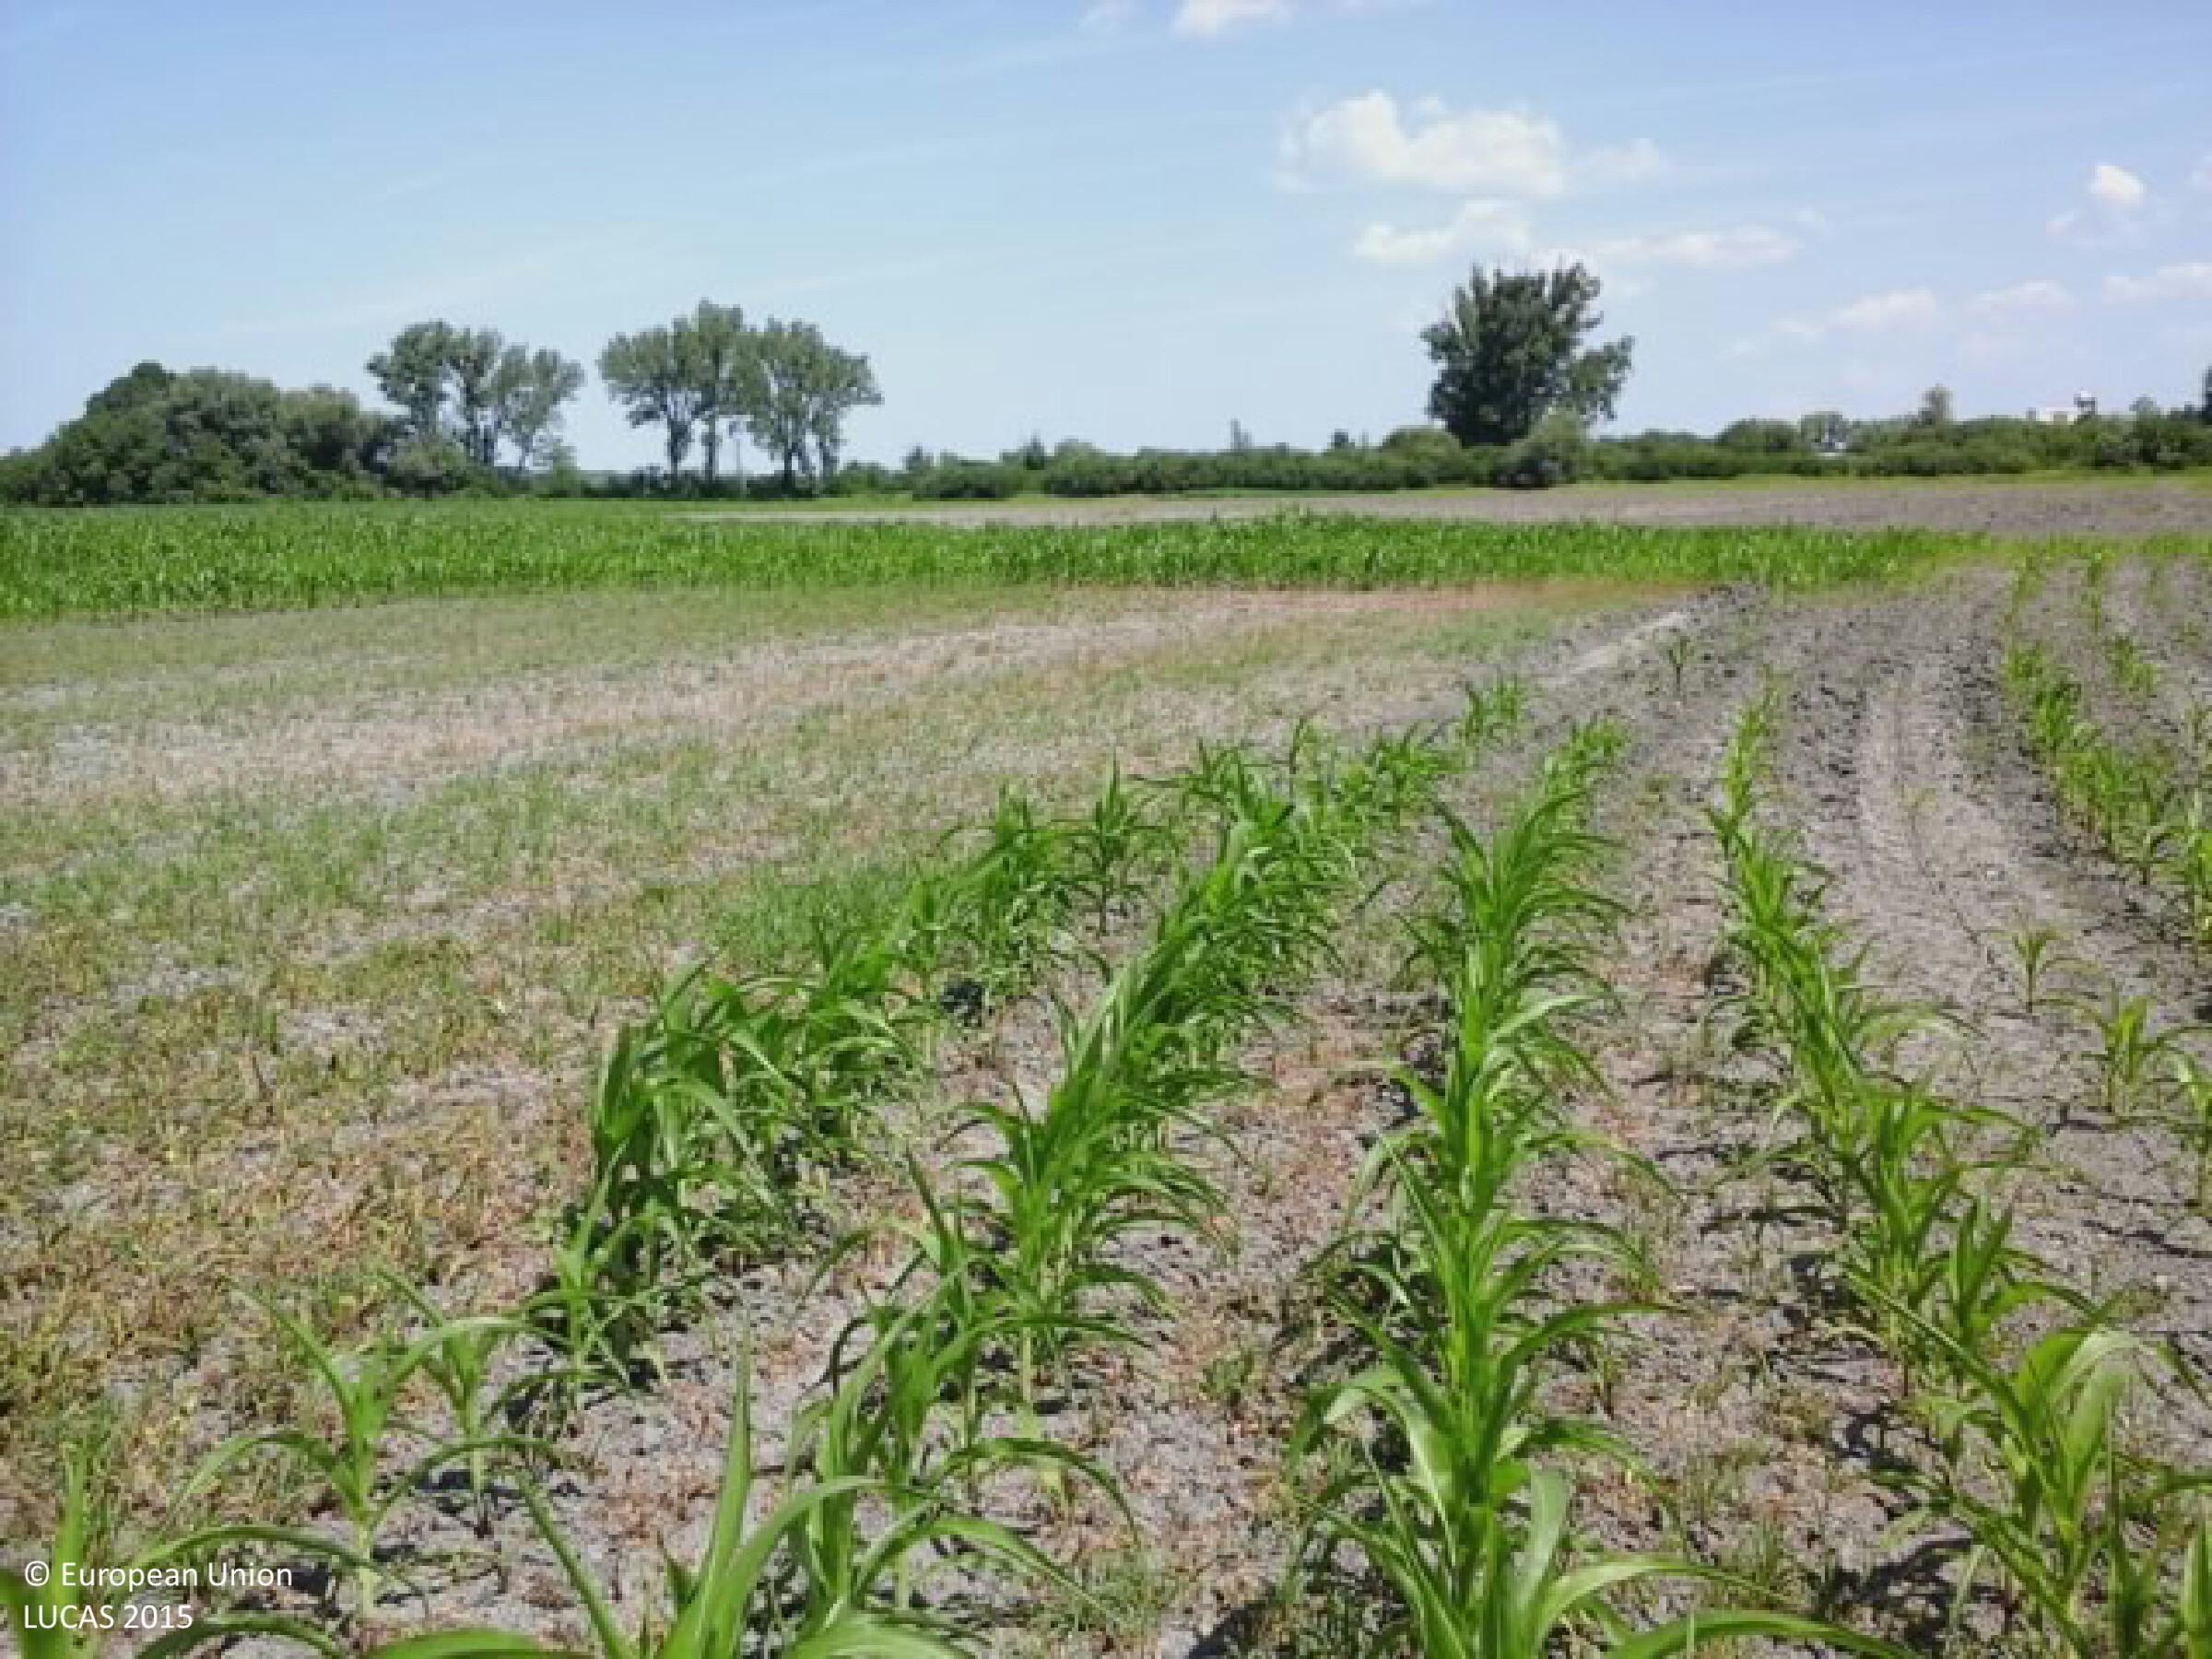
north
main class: Cropland
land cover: Maize
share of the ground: 25 - 50 %
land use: Agriculture (excluding fallow land and kitchen gardens)
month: July
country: HU
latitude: 45.9793
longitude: 18.9042
